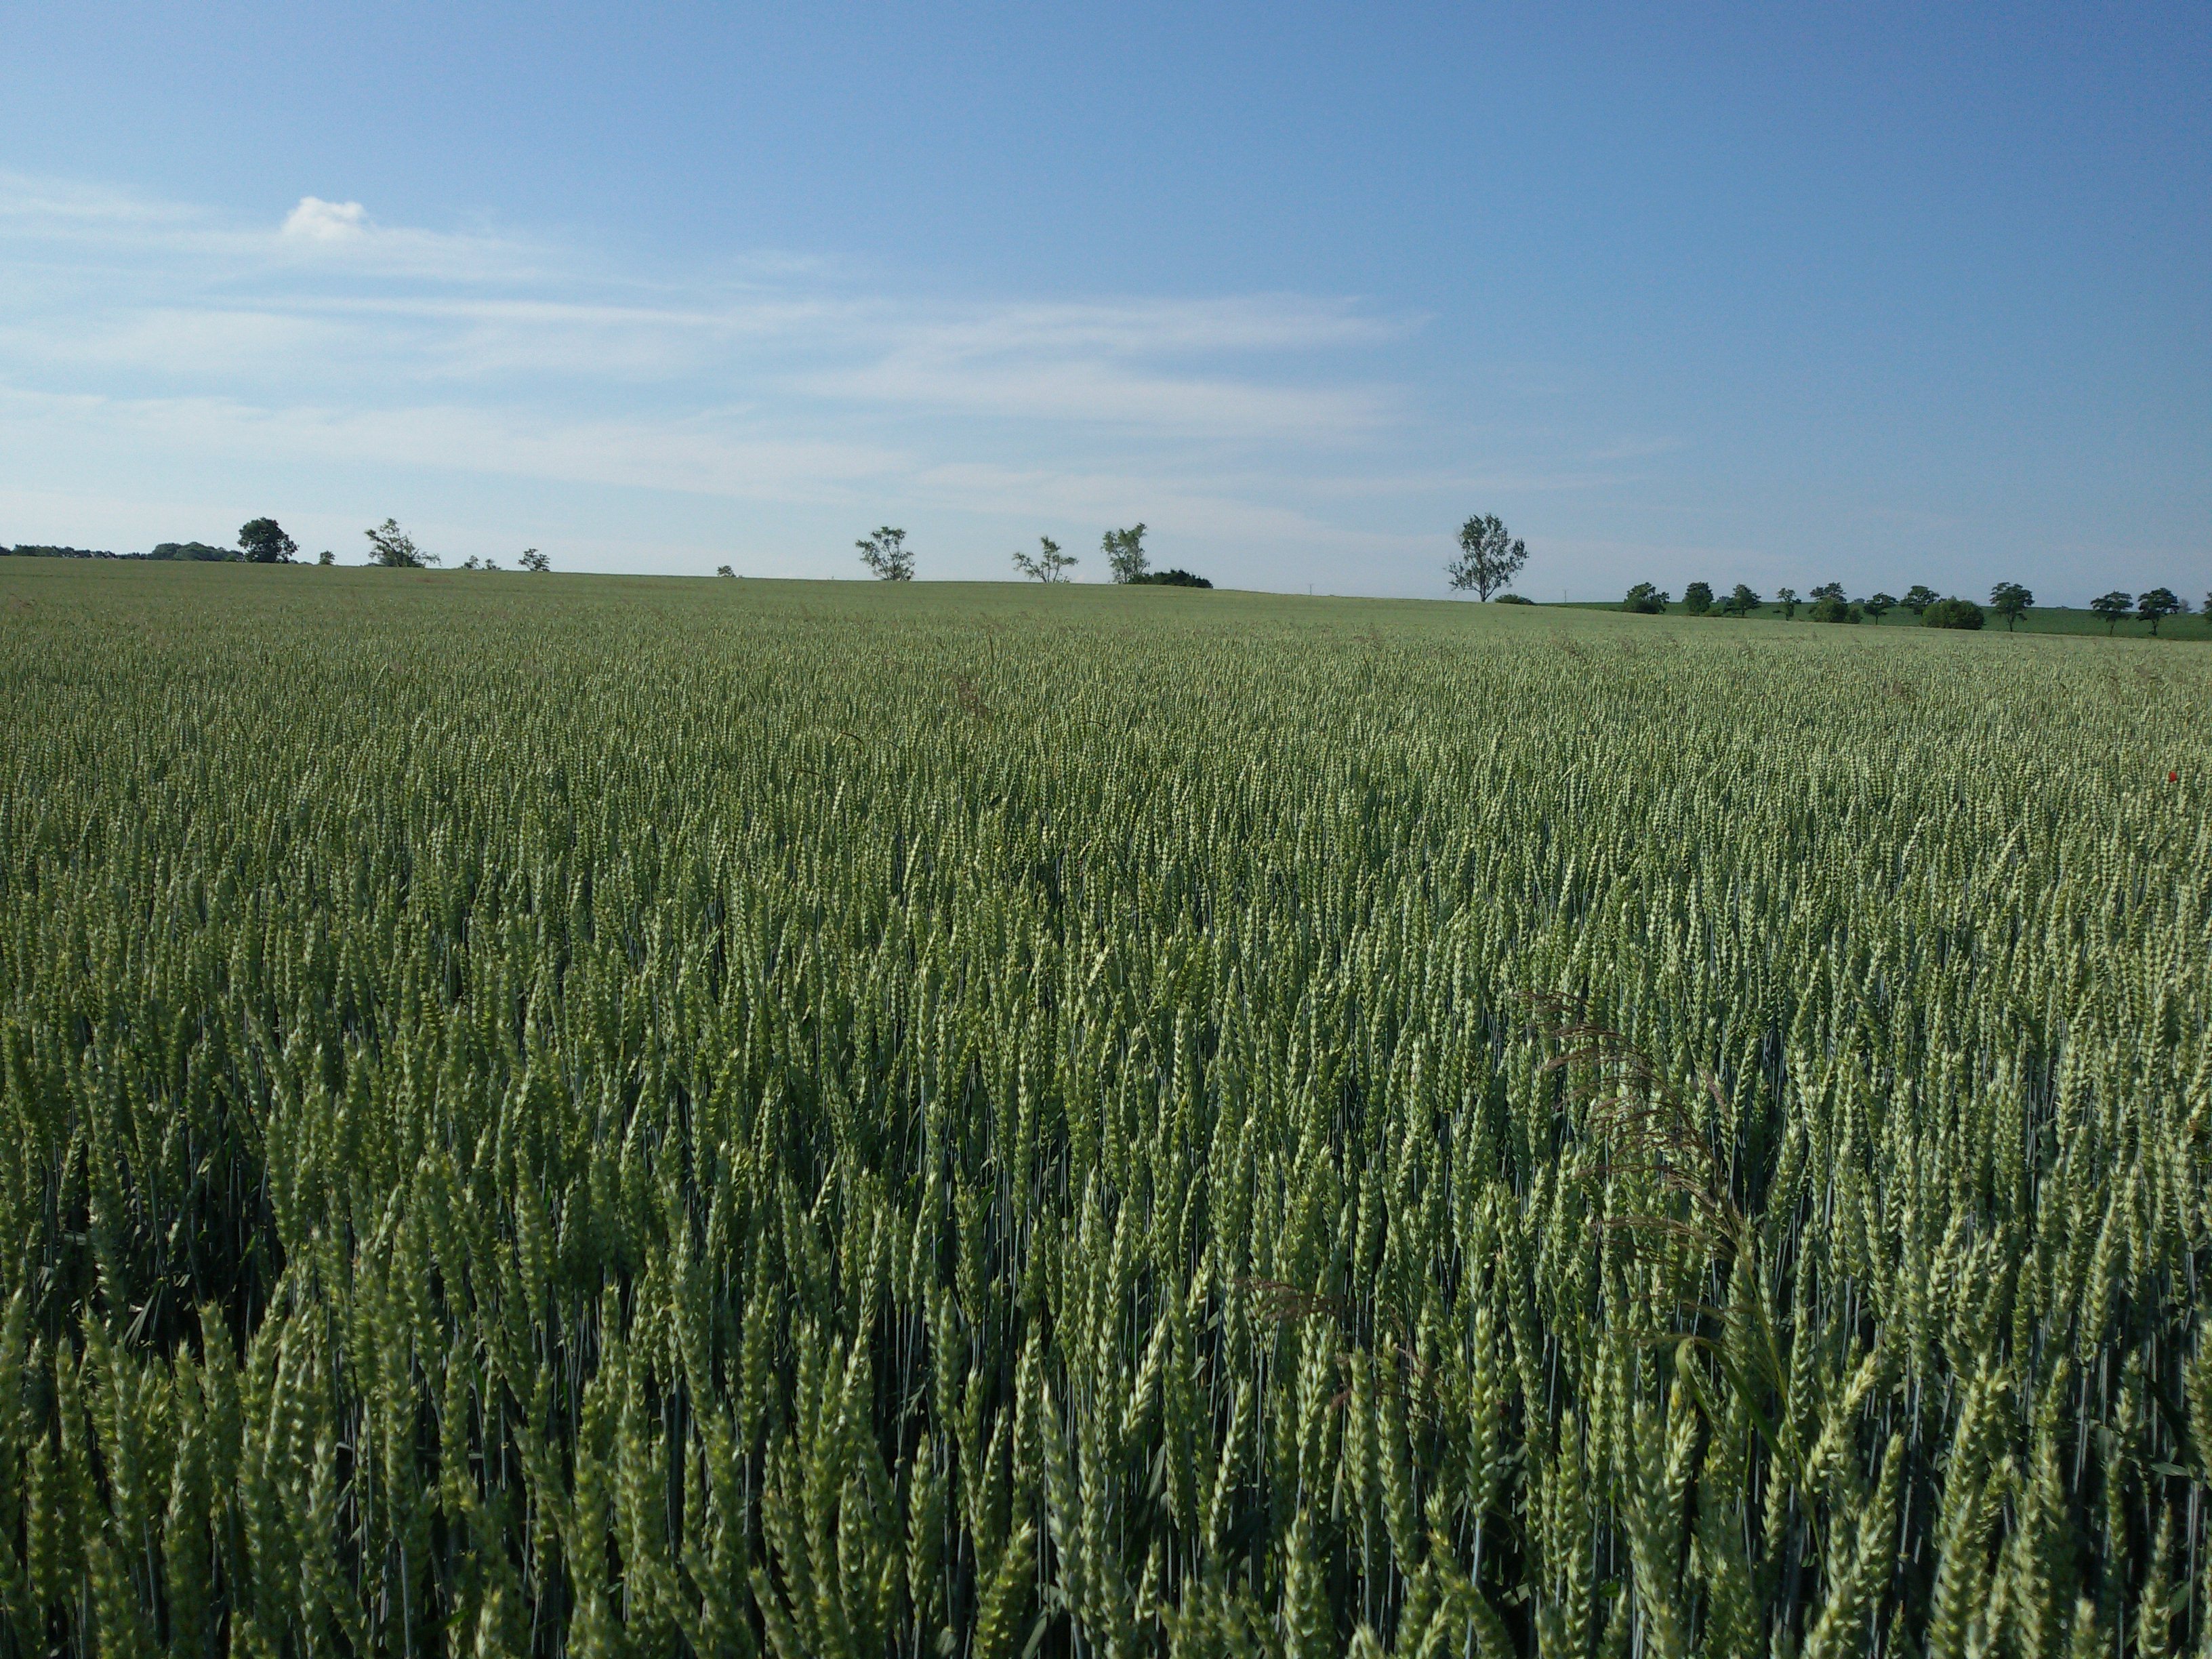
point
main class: Cropland
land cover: Common wheat
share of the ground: > 75 %
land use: Agriculture (excluding fallow land and kitchen gardens)
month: June
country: PL
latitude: 50.8208
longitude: 17.2365
